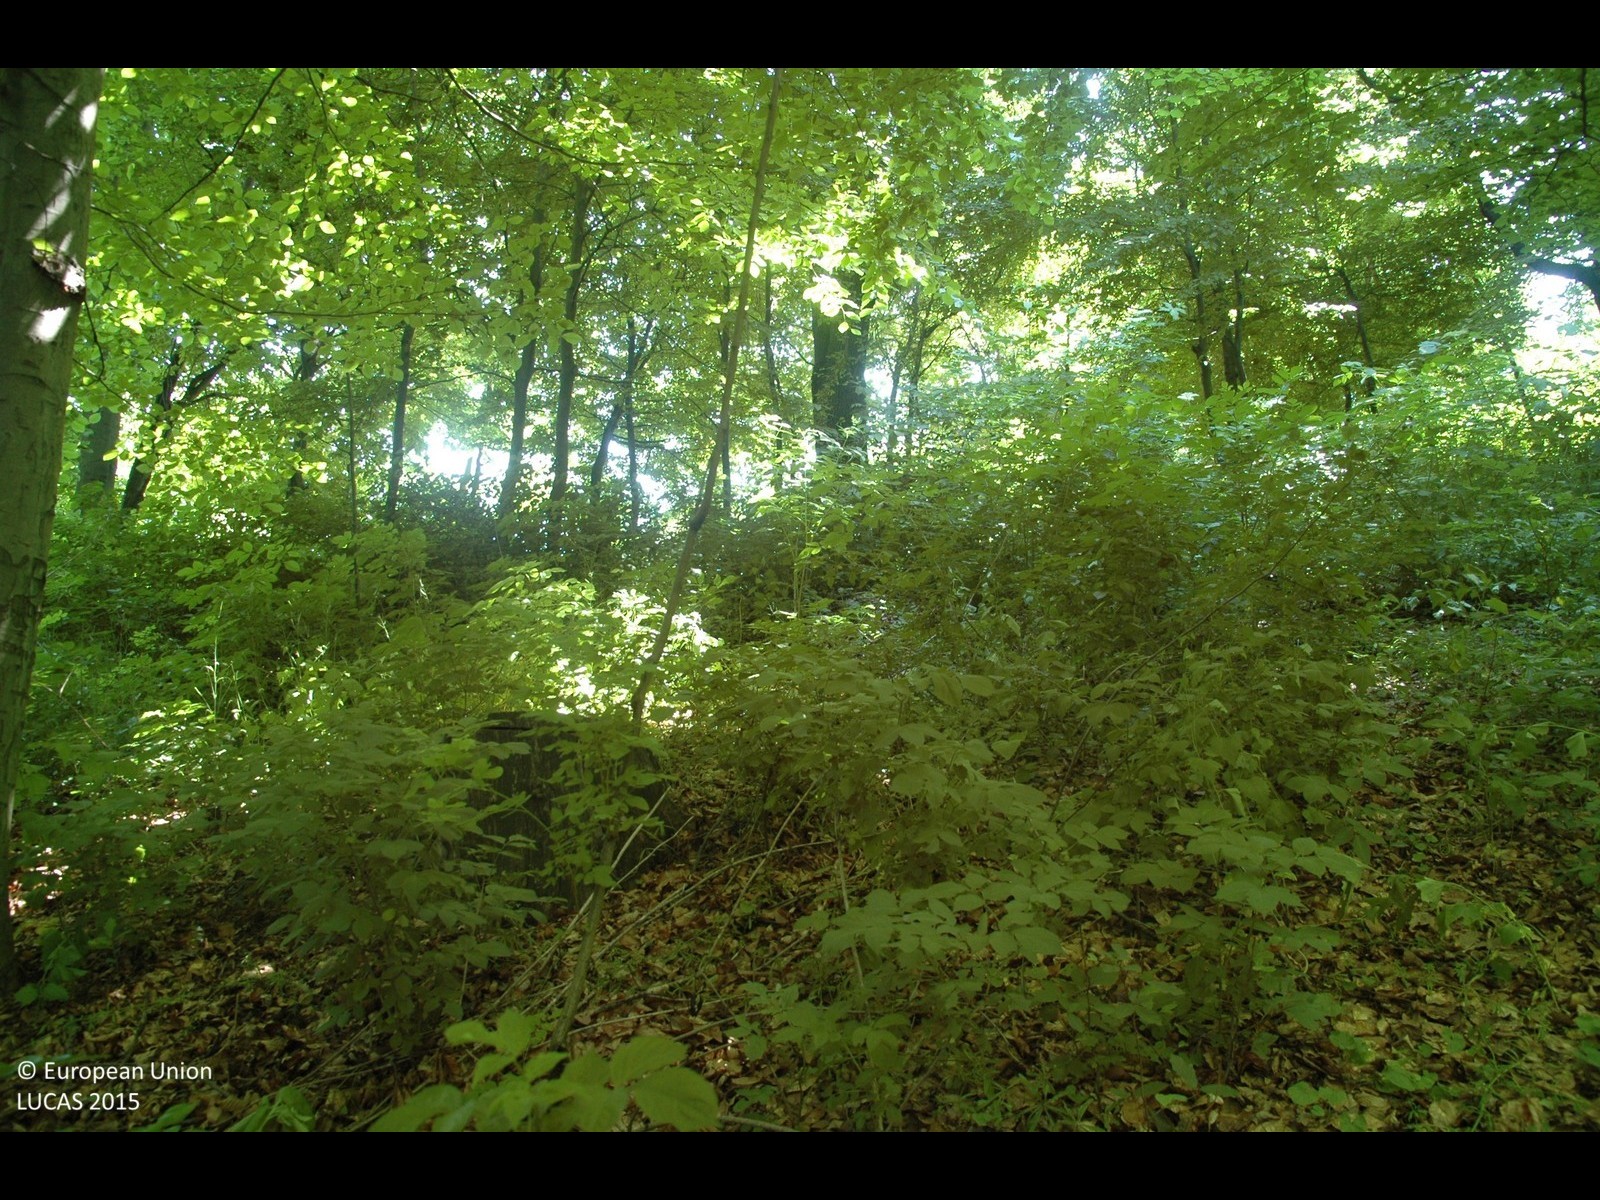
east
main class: Woodland
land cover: Broadleaved woodland
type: beech forest
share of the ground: > 75 %
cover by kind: broadleaved forest trees 90 %, shrubs 5 %, herbaceous plants 5 %
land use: Forestry
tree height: > 5 m
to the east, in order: Broadleaved woodland; Tracks; Fences; Pear fruit; Vineyards; Fences; Tracks; Broadleaved woodland
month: May
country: HR
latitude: 46.5043
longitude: 16.3731
